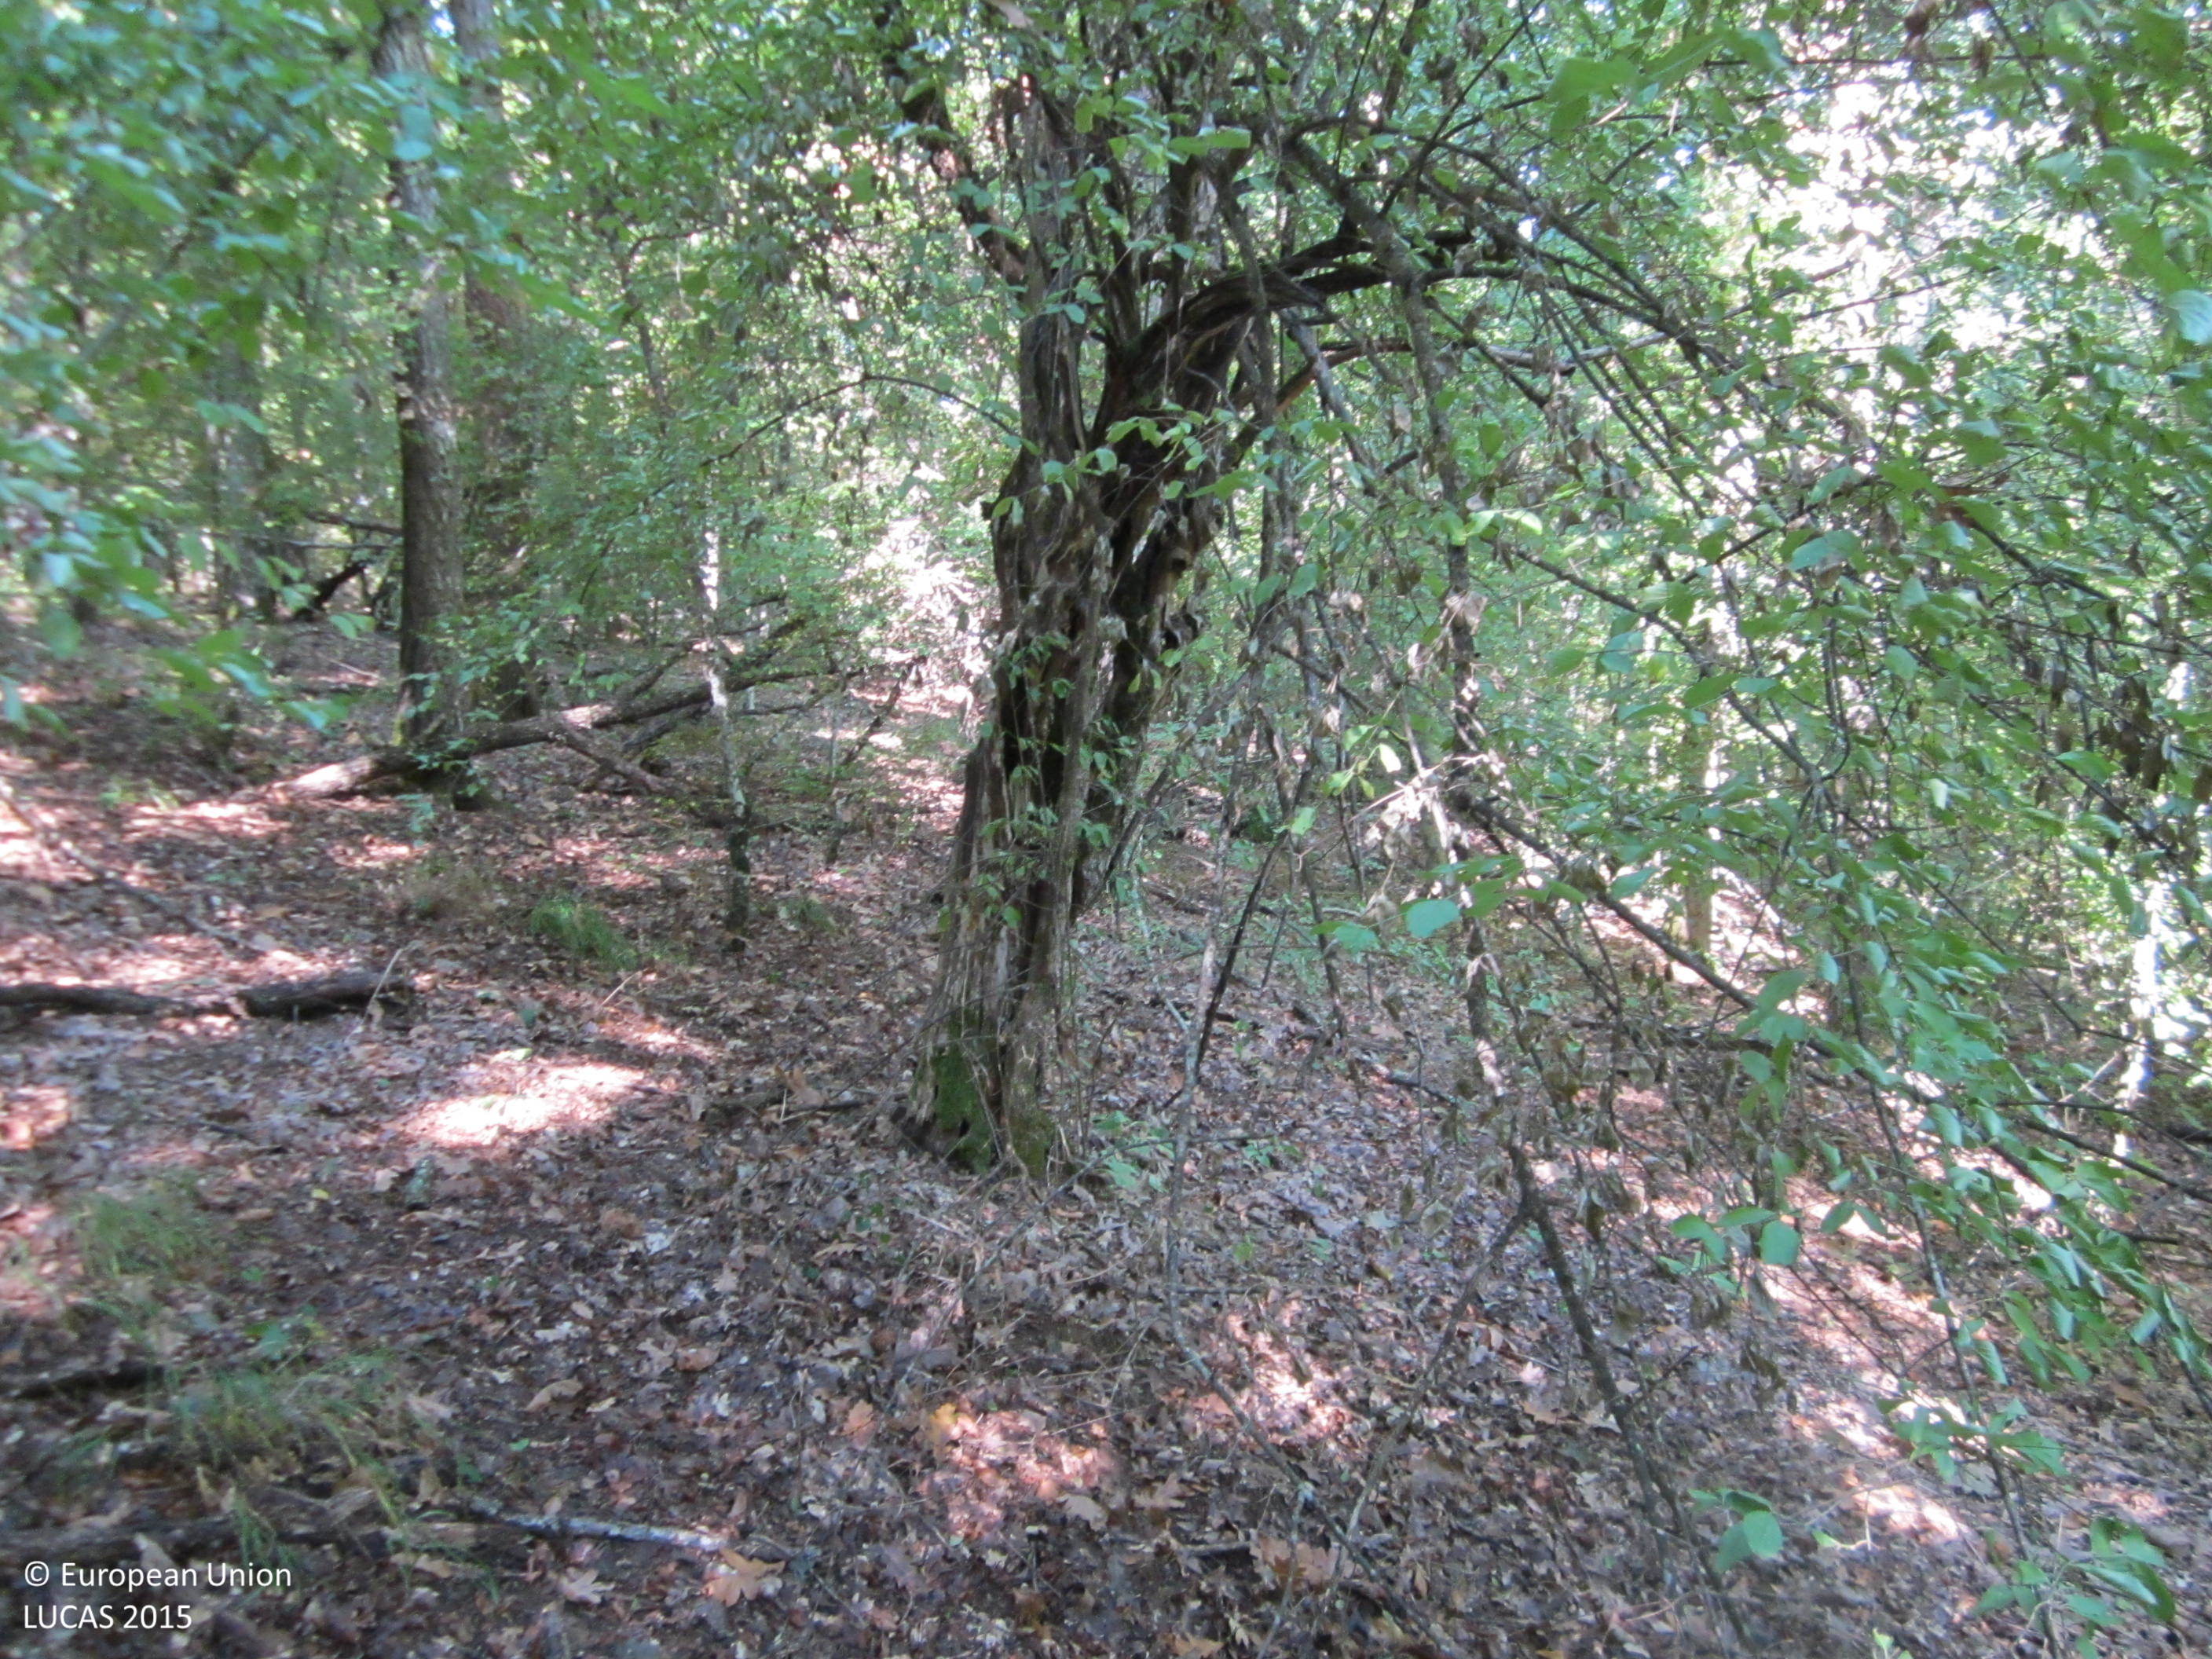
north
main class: Woodland
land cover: Broadleaved woodland
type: thermophilous deciduous forest
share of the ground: > 75 %
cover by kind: broadleaved forest trees 100 %
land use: Forestry
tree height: > 5 m
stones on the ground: < 10 %
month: September
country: BG
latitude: 42.2198
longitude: 27.1996
